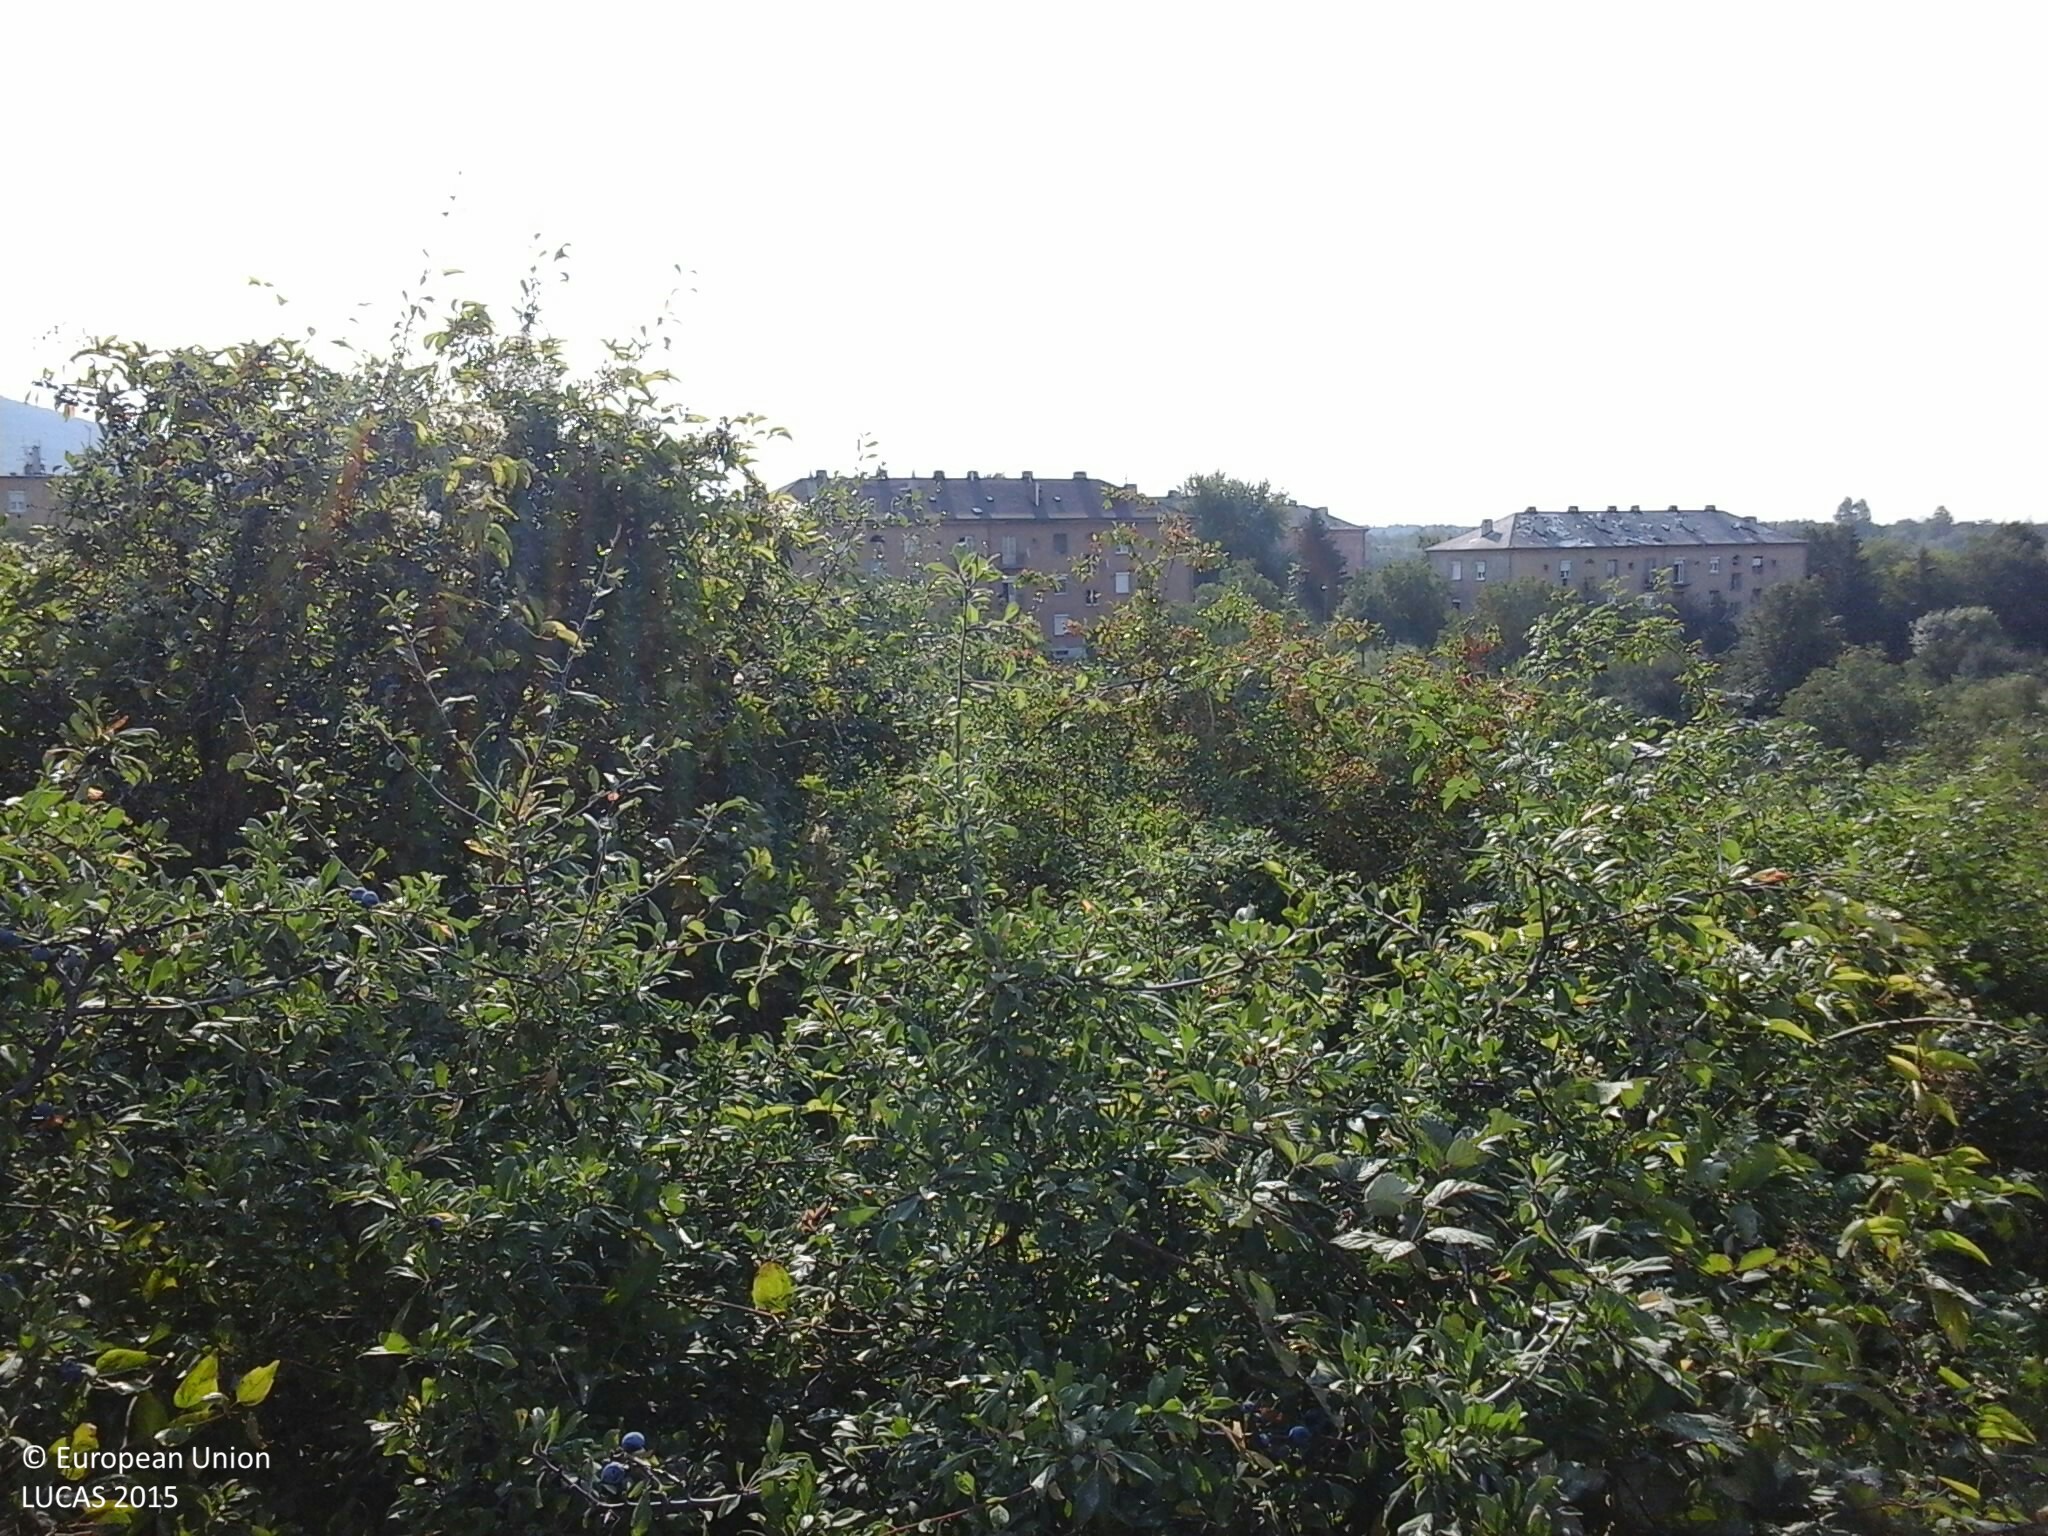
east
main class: Shrubland
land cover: Shrubland without tree cover
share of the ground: > 75 %
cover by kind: shrubs 100 %
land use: Semi-natural and natural areas not in use
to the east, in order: Shrubland without tree cover; Shrubland with sparse tree cover; Broadleaved woodland; Artificial constructions in urban areas
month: August
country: HU
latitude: 46.0788
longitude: 18.1141
